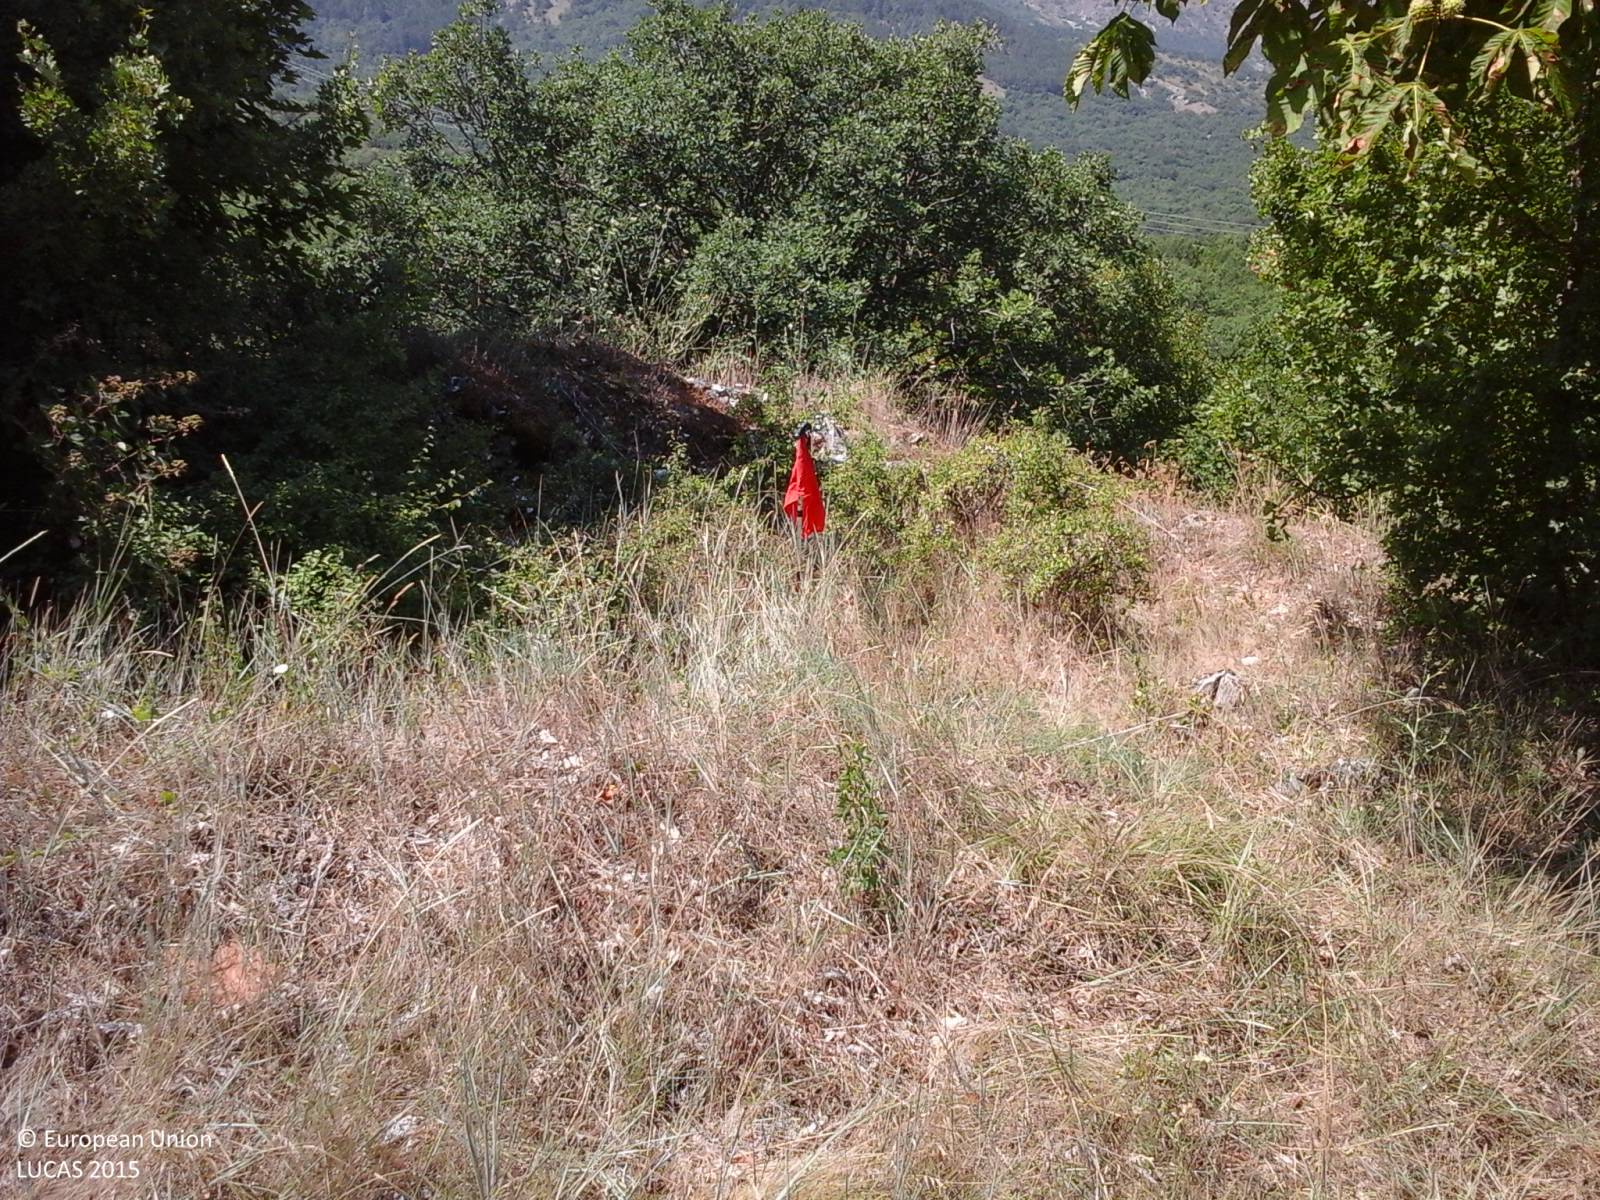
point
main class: Grassland
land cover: Grassland with sparse tree/shrub cover
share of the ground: > 75 %
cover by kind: herbaceous plants 90 %, broadleaved forest trees 5 %, shrubs 5 %
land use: Agriculture (excluding fallow land and kitchen gardens)
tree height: > 5 m
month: July
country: IT
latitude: 42.2873
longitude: 13.4693
